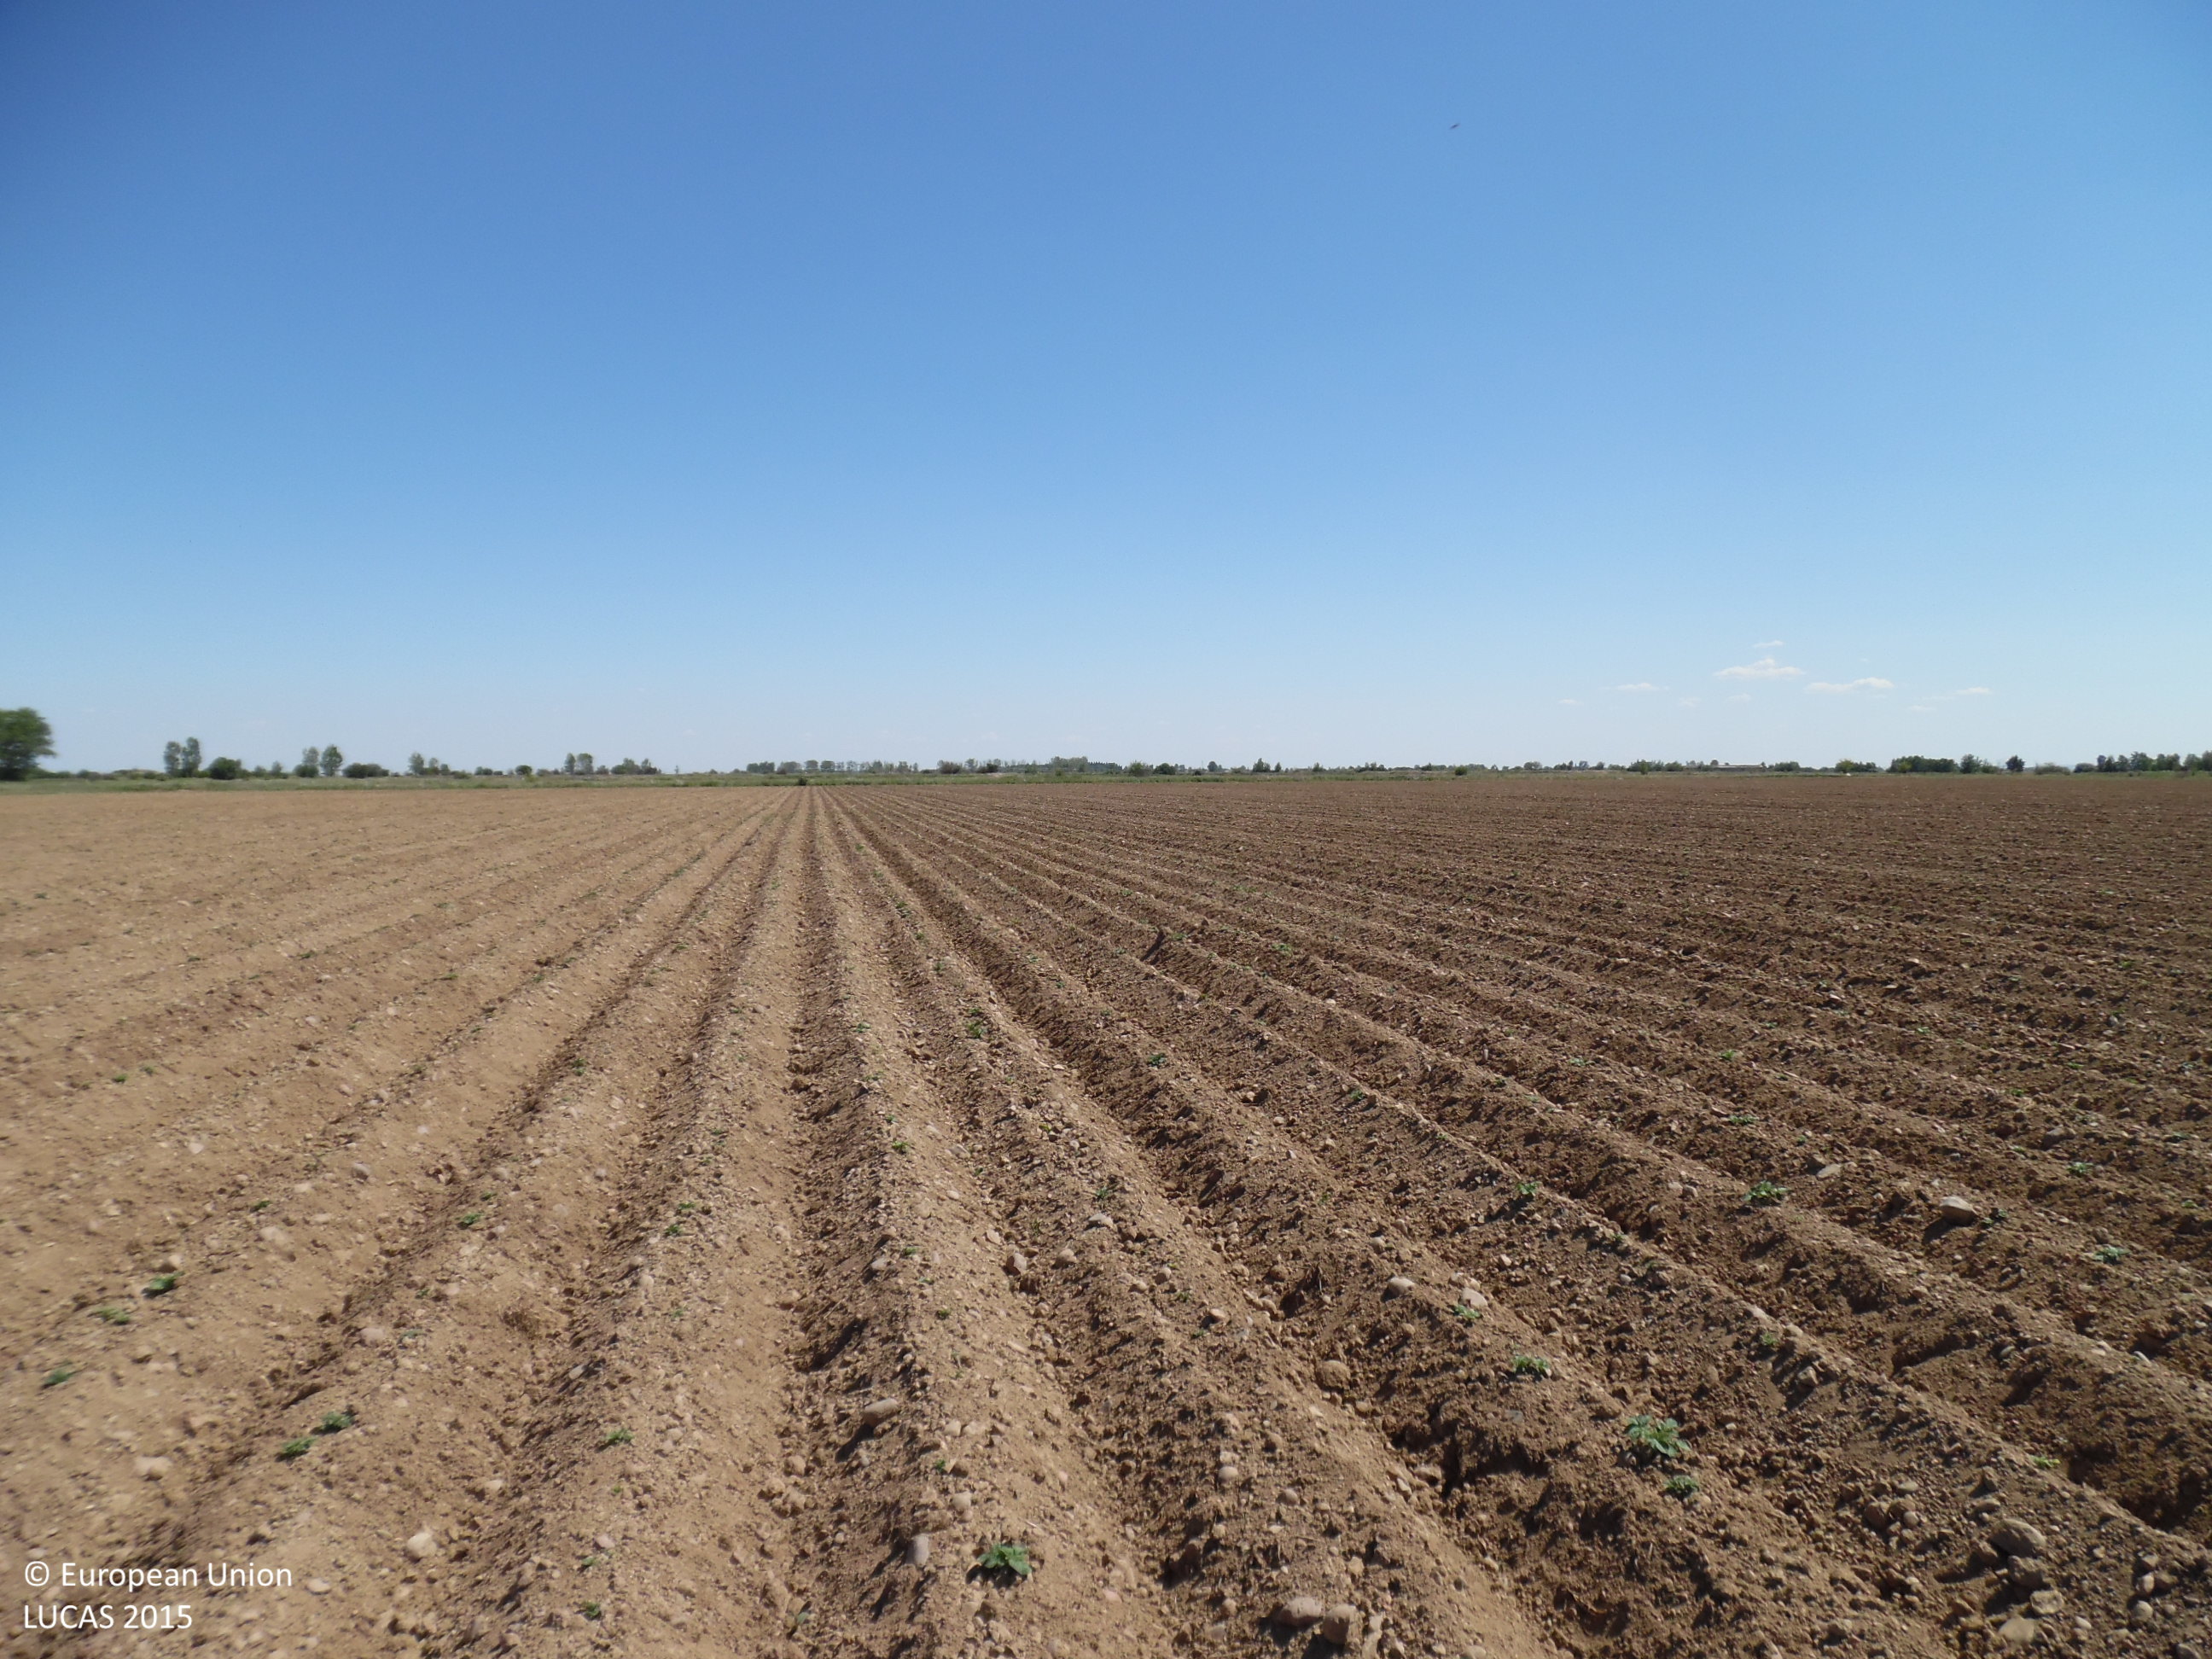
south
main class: Cropland
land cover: Potatoes
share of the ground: < 10 %
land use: Agriculture (excluding fallow land and kitchen gardens)
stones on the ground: 10 - 25 %
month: June
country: ES
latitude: 42.4280
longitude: -5.7168
